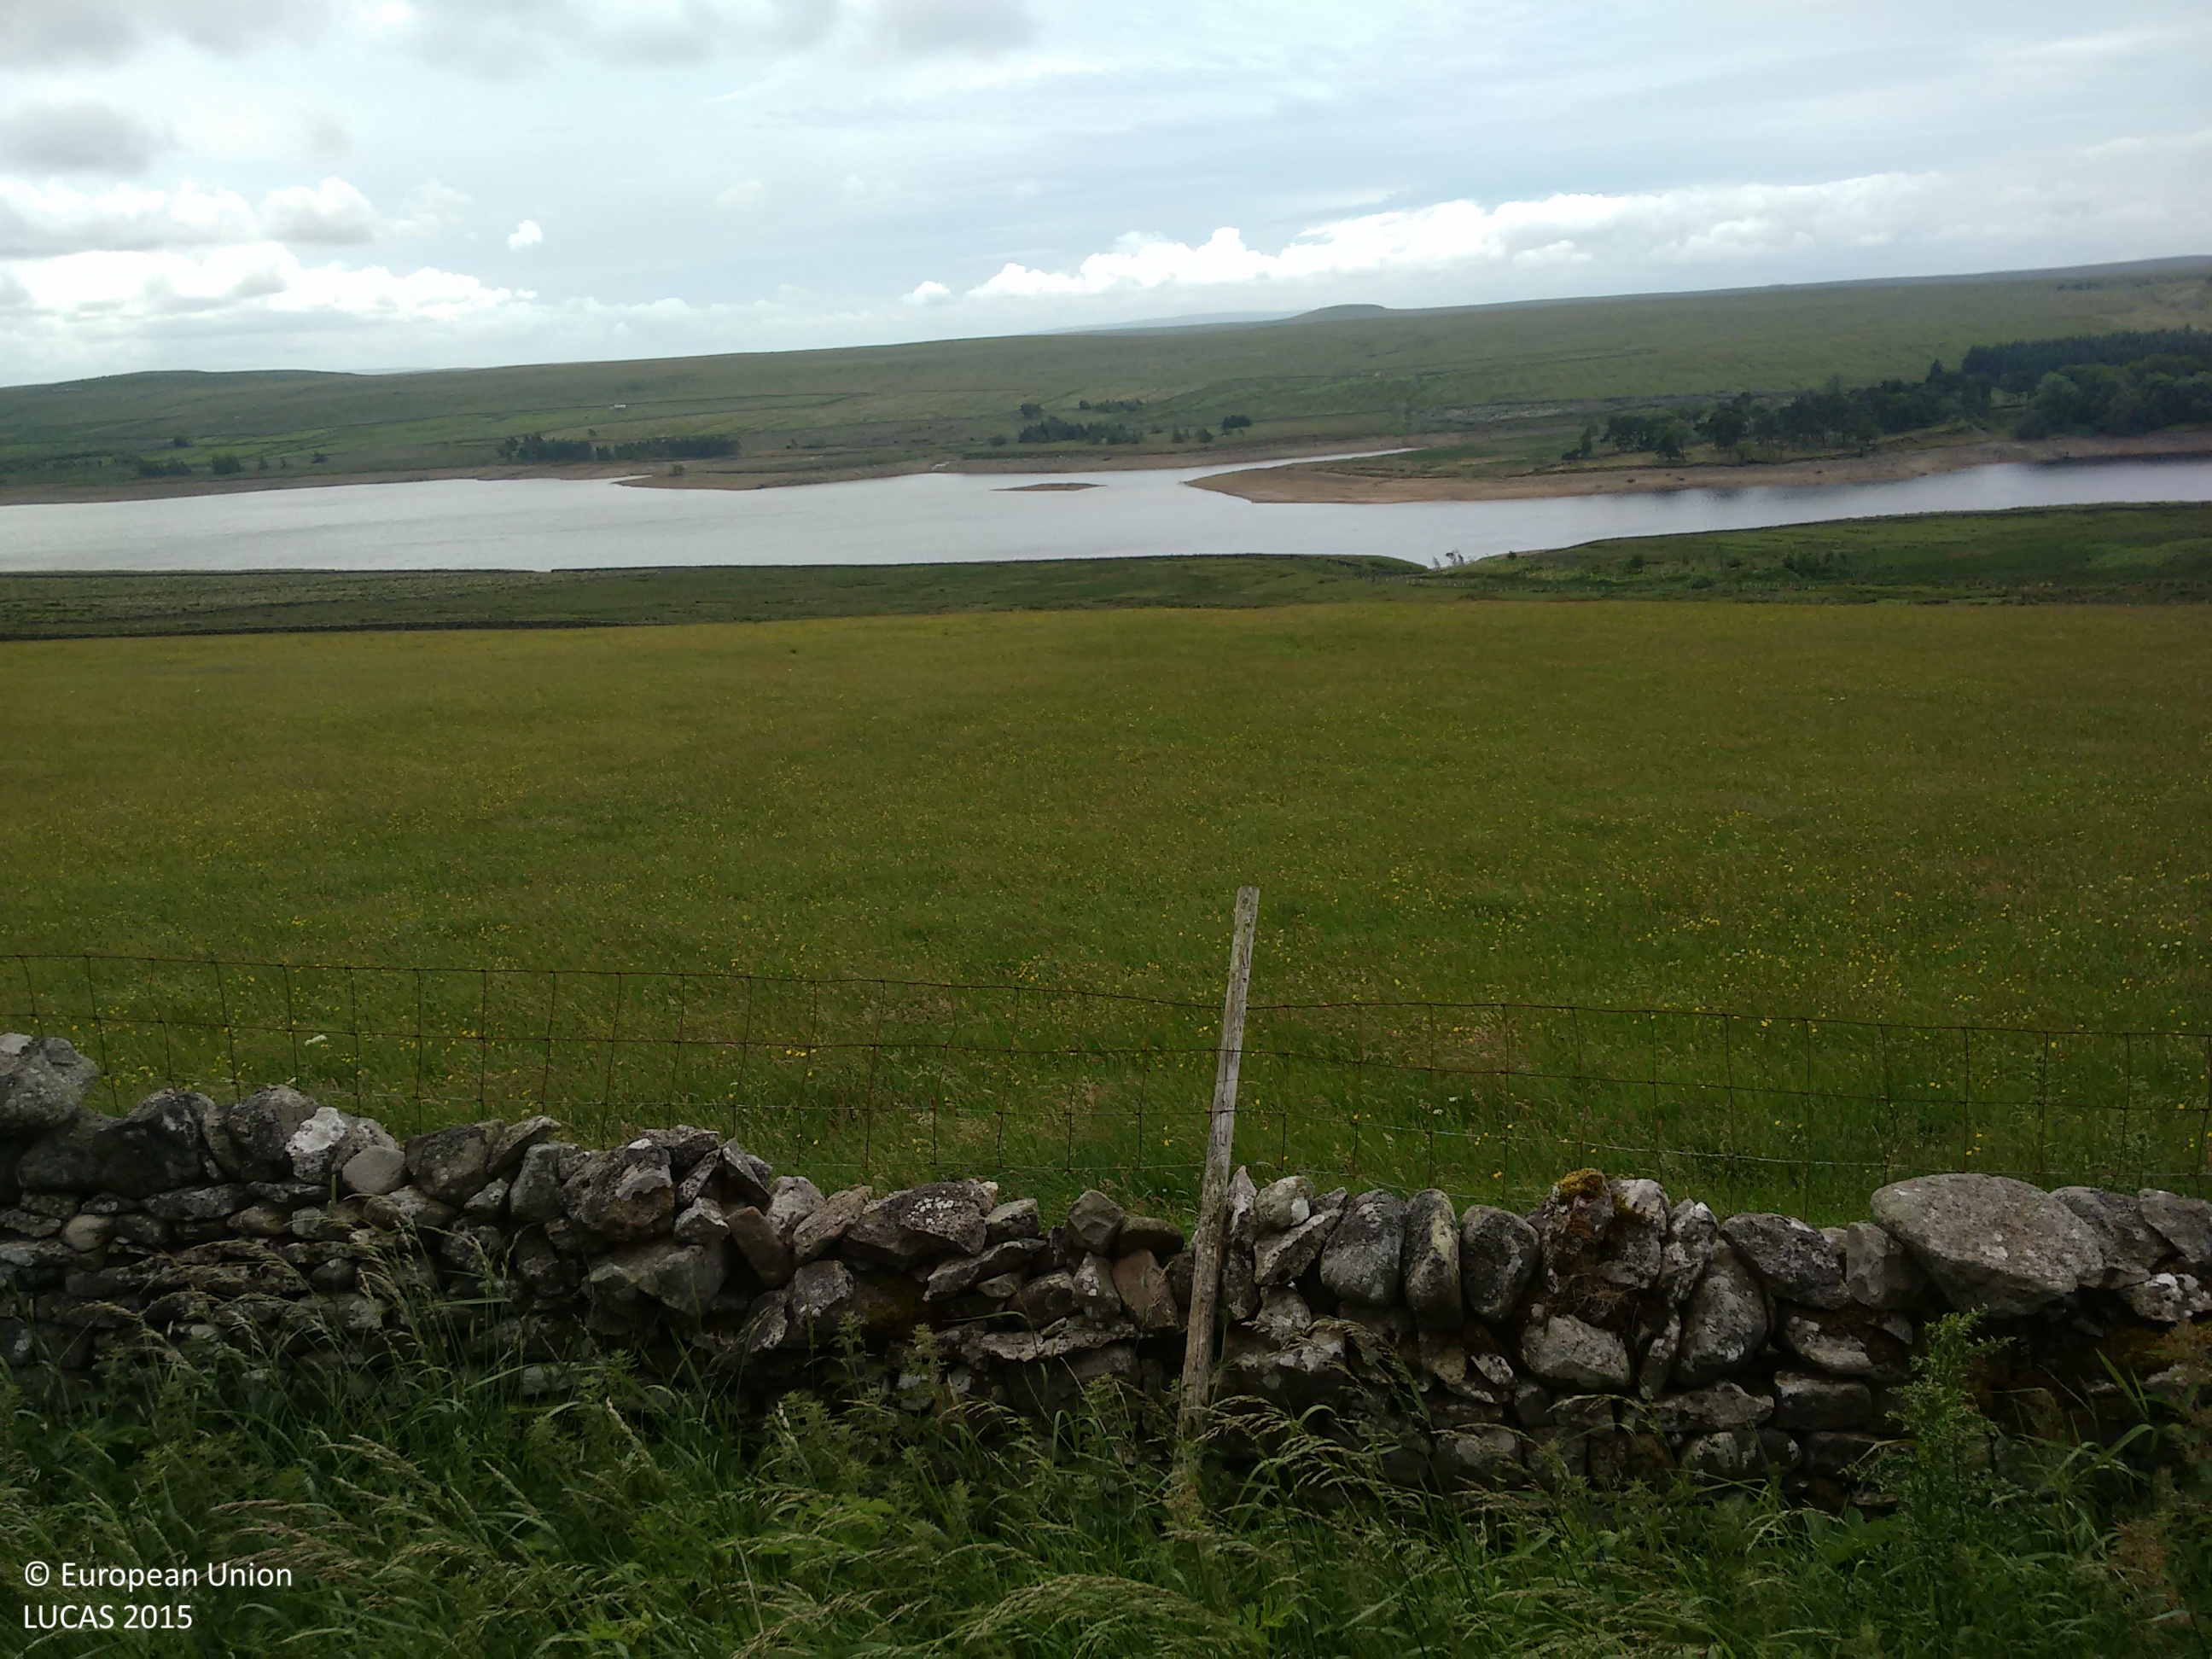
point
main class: Grassland
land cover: Grassland without tree/shrub cover
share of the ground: > 75 %
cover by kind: herbaceous plants 100 %
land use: Water supply and treatment
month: July
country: GB
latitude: 54.5892
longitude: -2.1439
